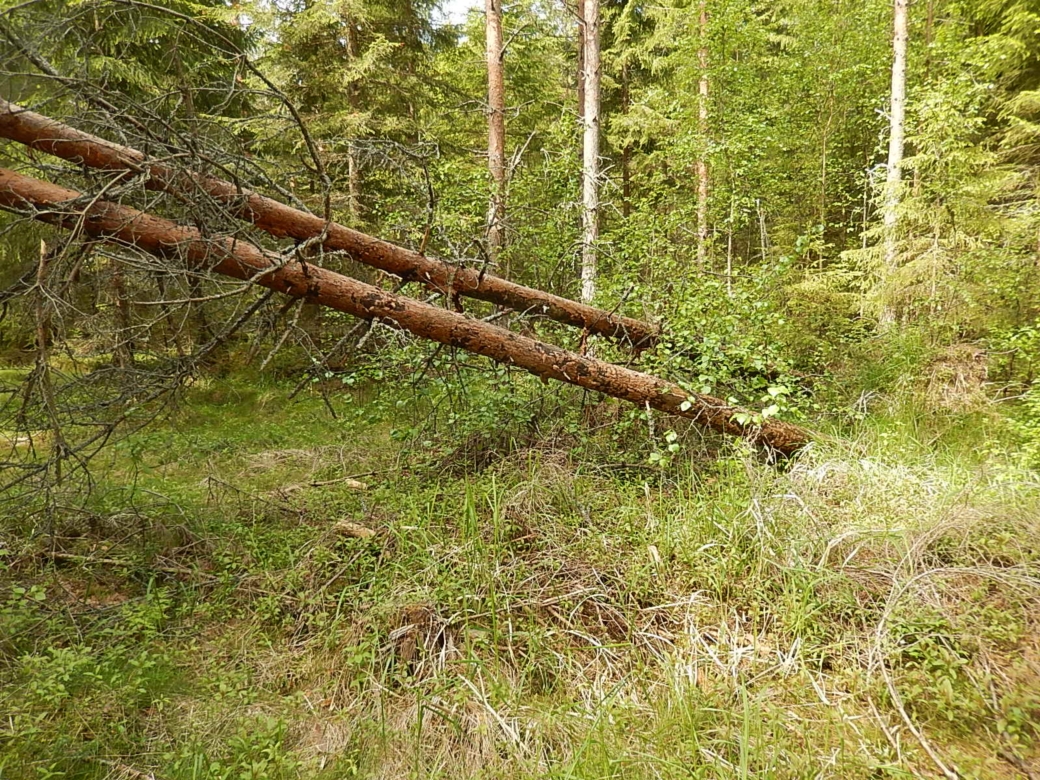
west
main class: Woodland
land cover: Other coniferous woodland
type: boreal forest
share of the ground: > 75 %
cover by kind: coniferous forest trees 70 %, broadleaved forest trees 10 %, shrubs 10 %, herbaceous plants 10 %
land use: Forestry
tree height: > 5 m
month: June
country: FI
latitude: 61.9155
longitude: 21.4912
